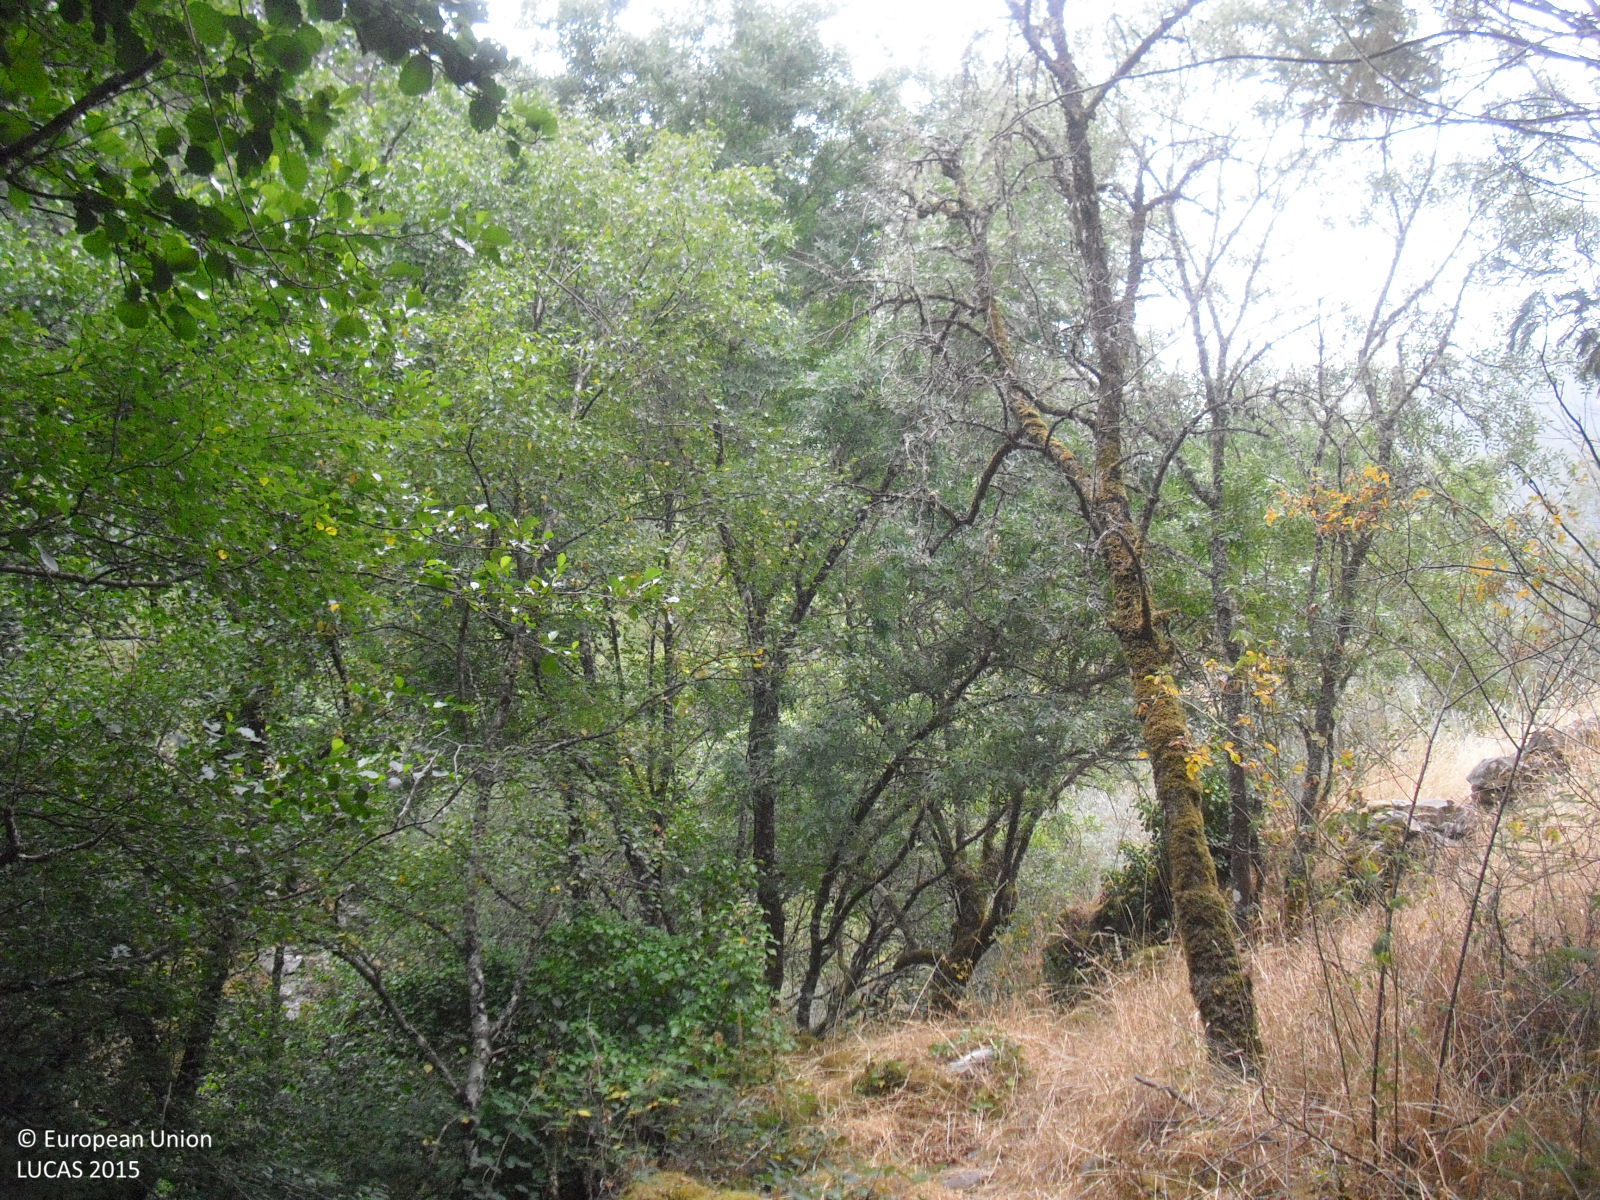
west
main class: Woodland
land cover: Broadleaved woodland
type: thermophilous deciduous forest
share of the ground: 50 - 75 %
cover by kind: broadleaved forest trees 60 %, shrubs 30 %, consolidated bare surface 10 %
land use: Semi-natural and natural areas not in use
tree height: > 5 m
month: July
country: ES
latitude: 42.5169
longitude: -7.7122
